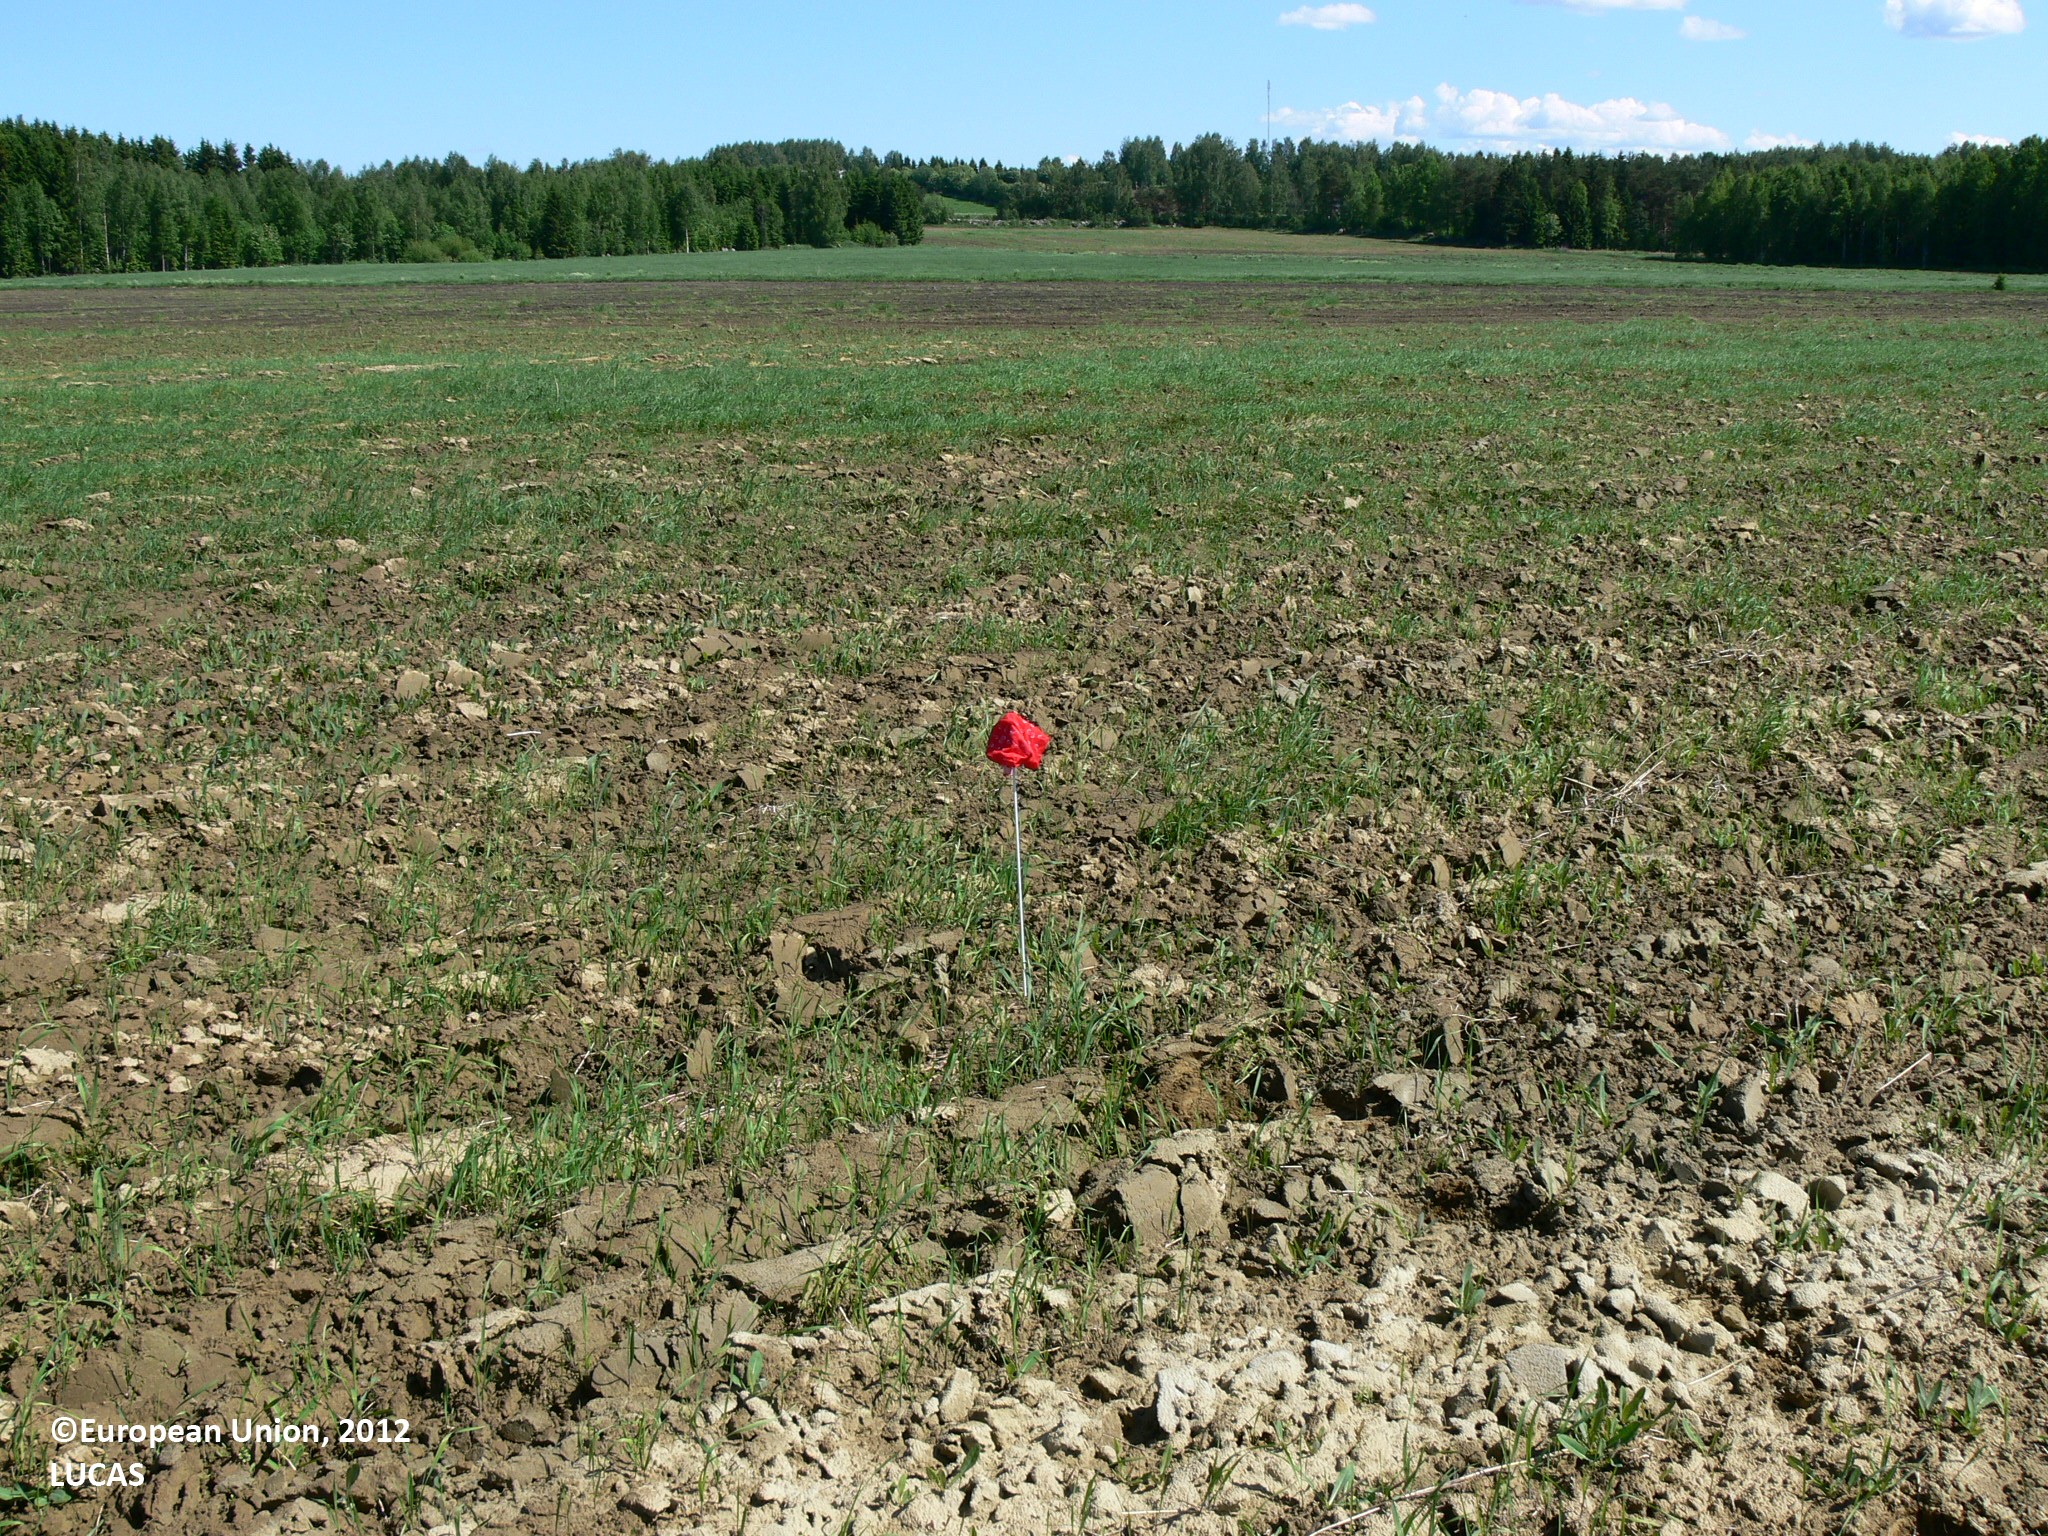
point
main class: Grassland
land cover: Spontaneously vegetated surfaces
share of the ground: < 10 %
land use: Fallow land
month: June
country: FI
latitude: 62.3193
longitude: 30.3657
